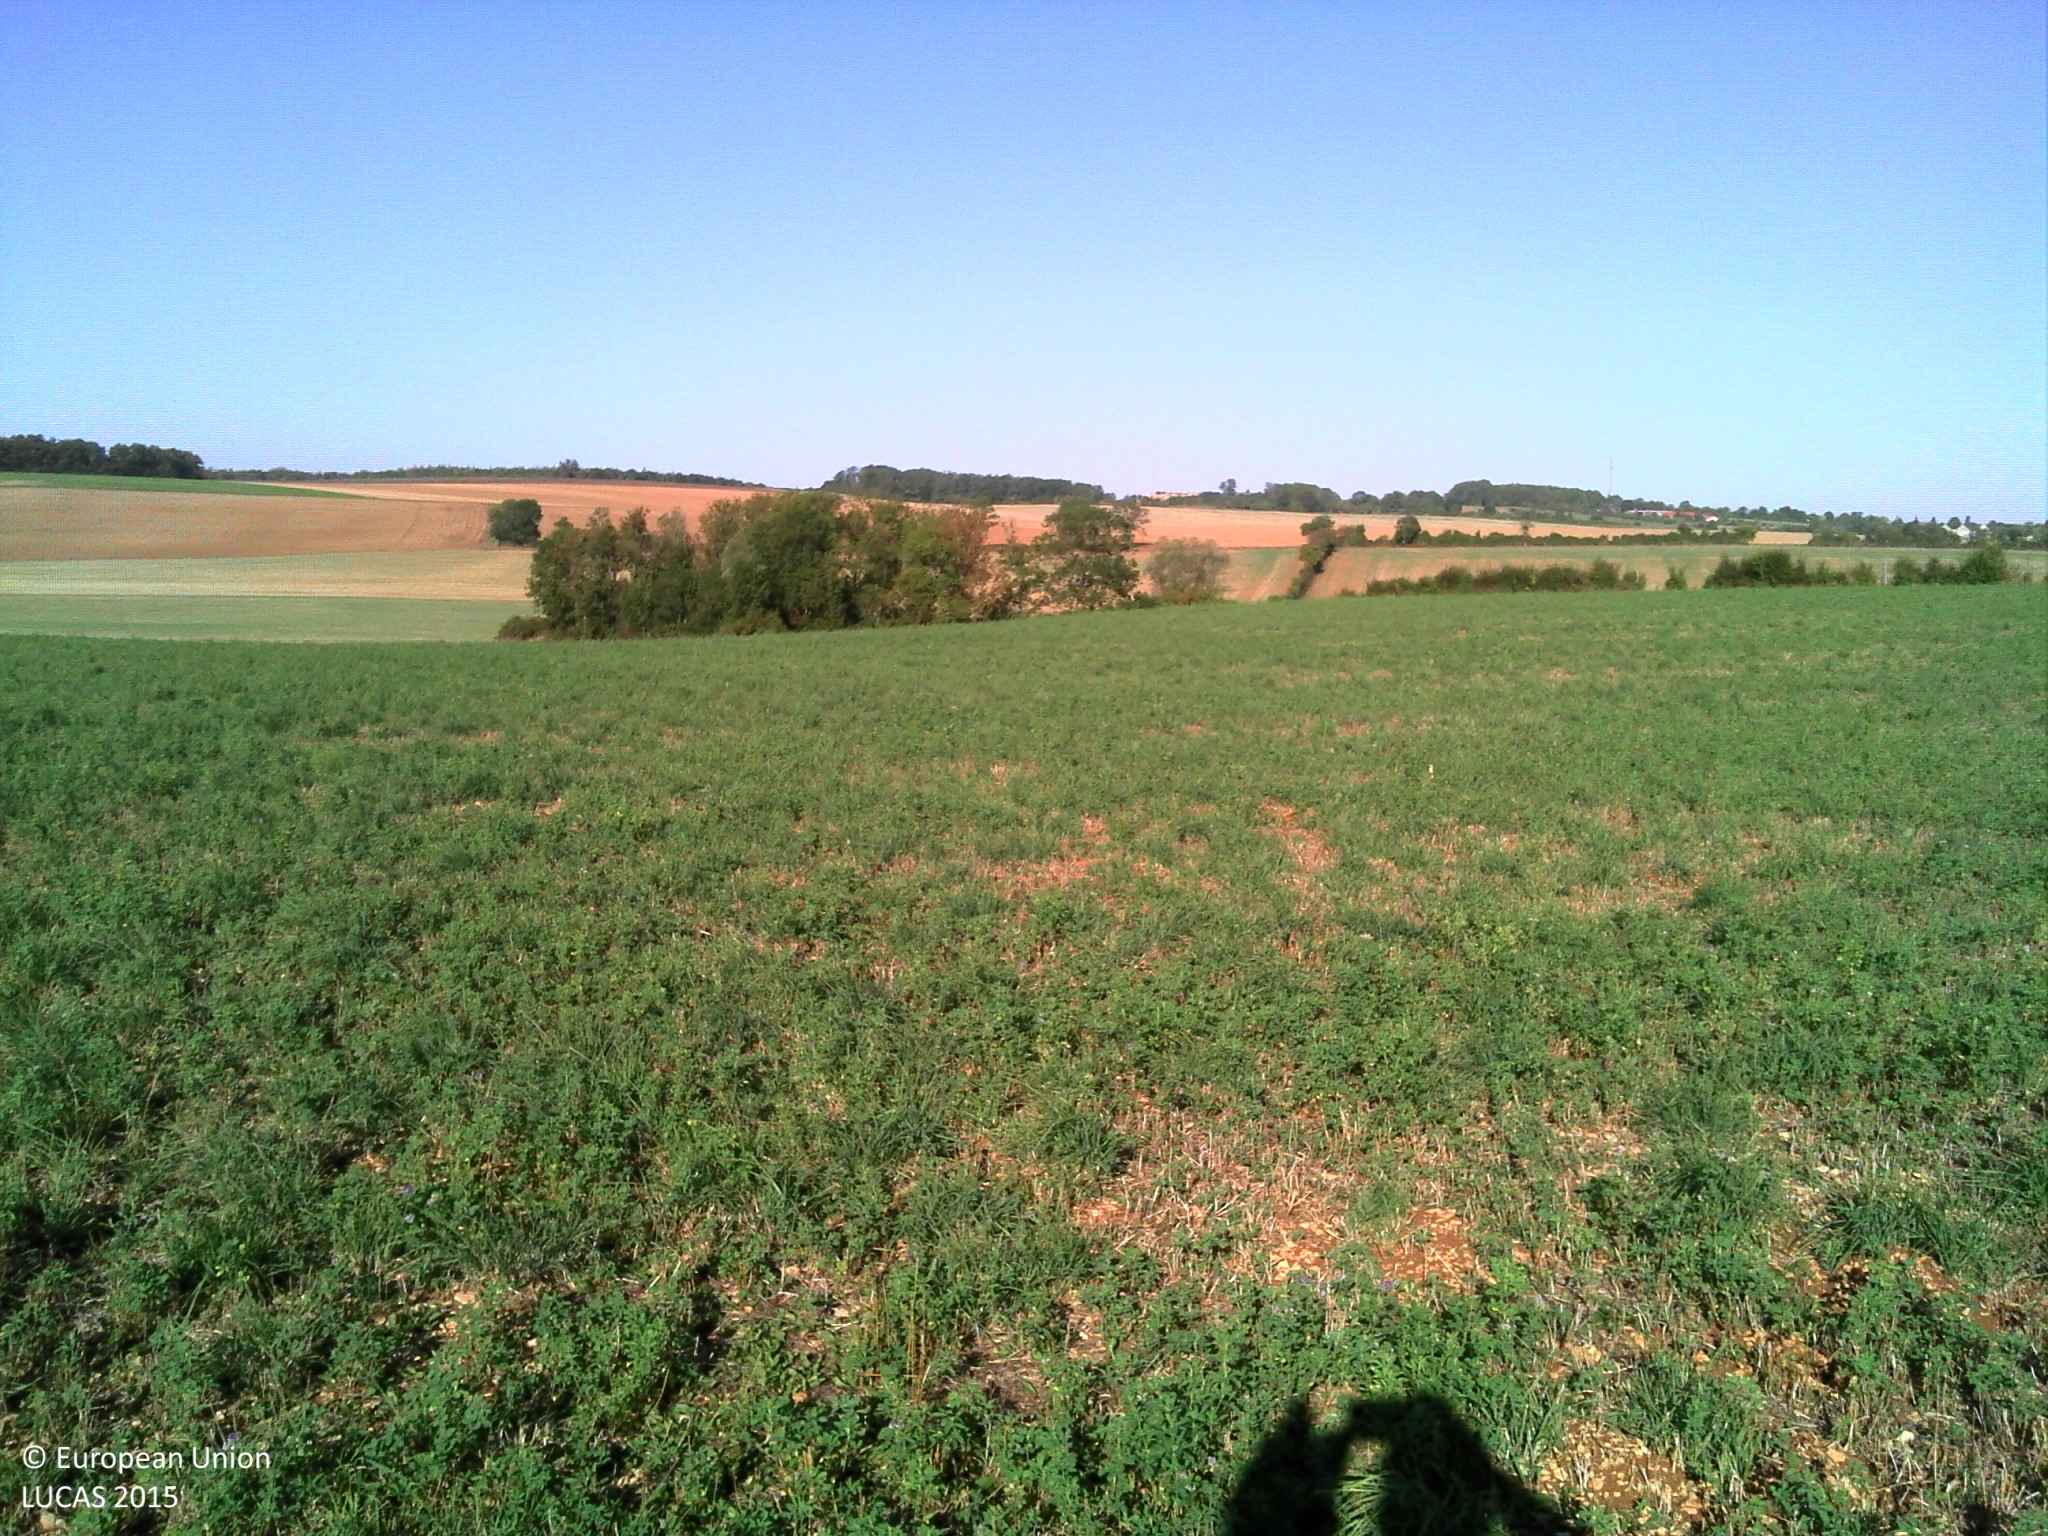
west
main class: Cropland
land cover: Lucerne
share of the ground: > 75 %
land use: Agriculture (excluding fallow land and kitchen gardens)
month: September
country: FR
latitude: 47.5895
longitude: 4.6669
